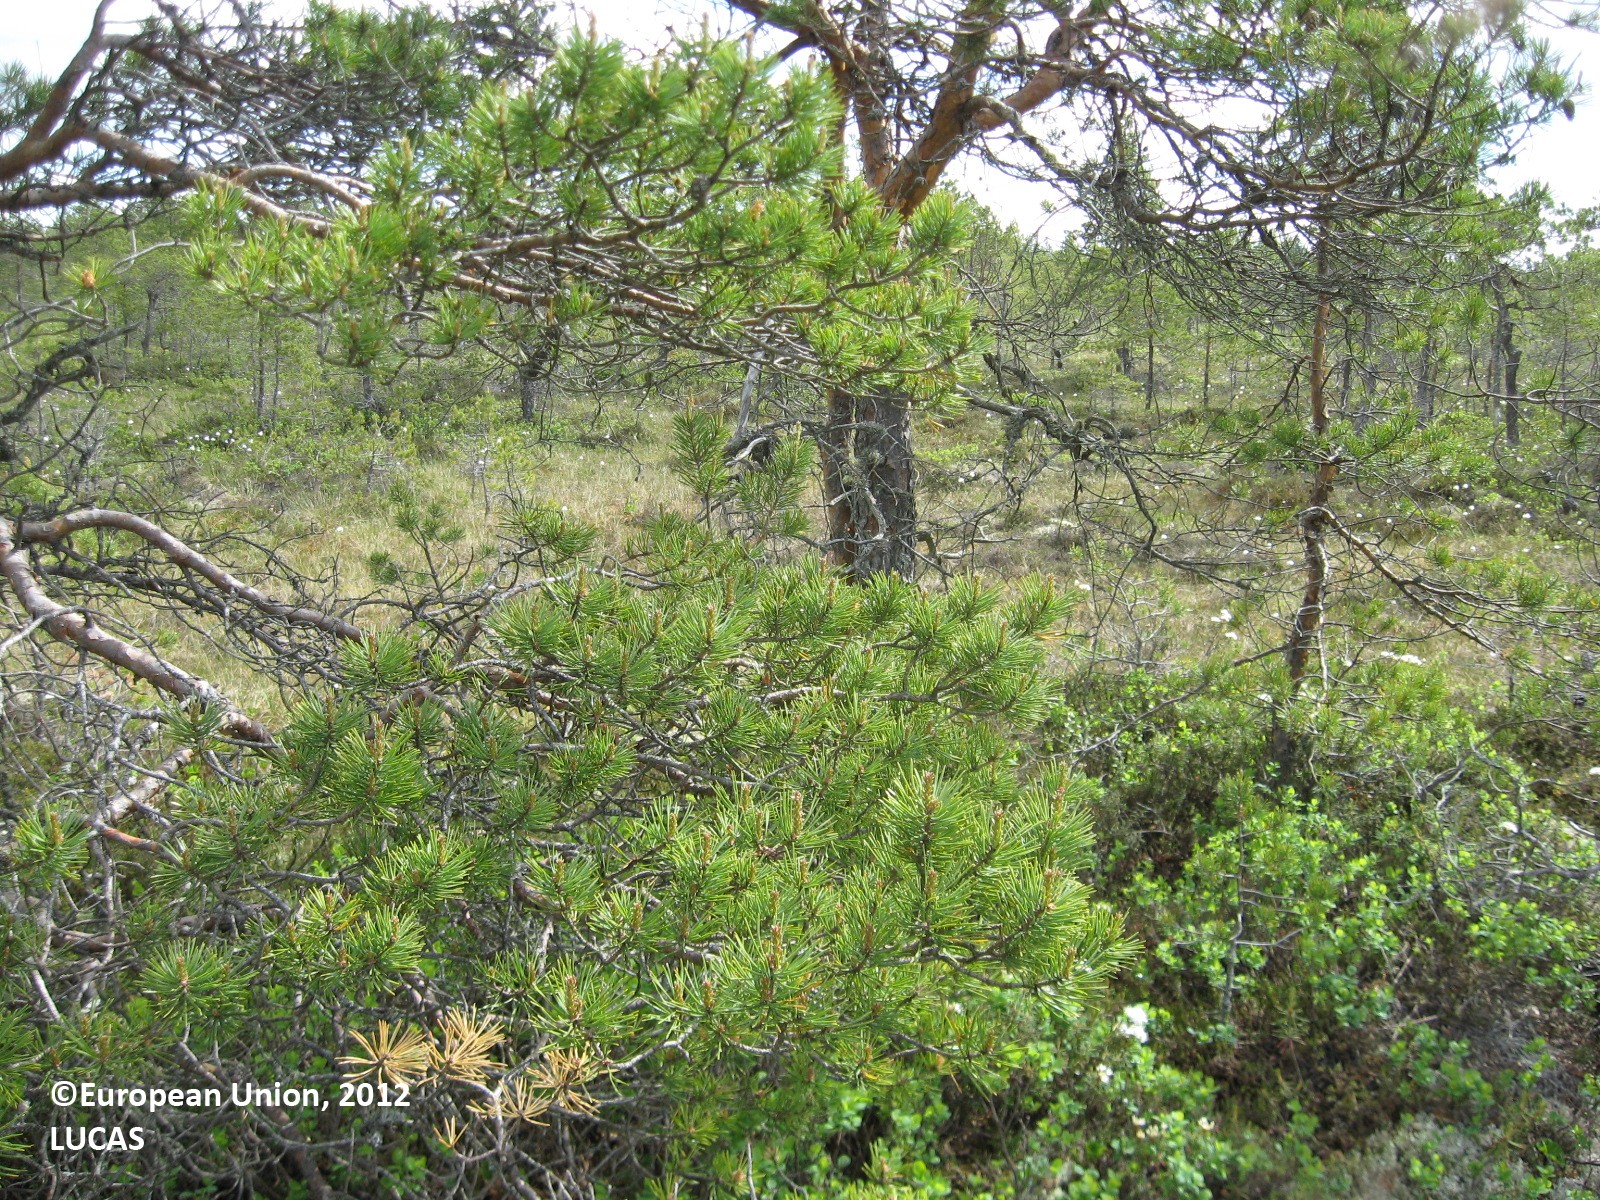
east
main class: Woodland
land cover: Pine dominated coniferous woodland
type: mire and swamp forests
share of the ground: 25 - 50 %
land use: Forestry
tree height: > 5 m
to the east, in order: Pine dominated coniferous woodland; Ditches and canals; Pine dominated coniferous woodland; Ditches and canals; Pine dominated coniferous woodland
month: June
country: FI
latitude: 63.0997
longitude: 22.6729
